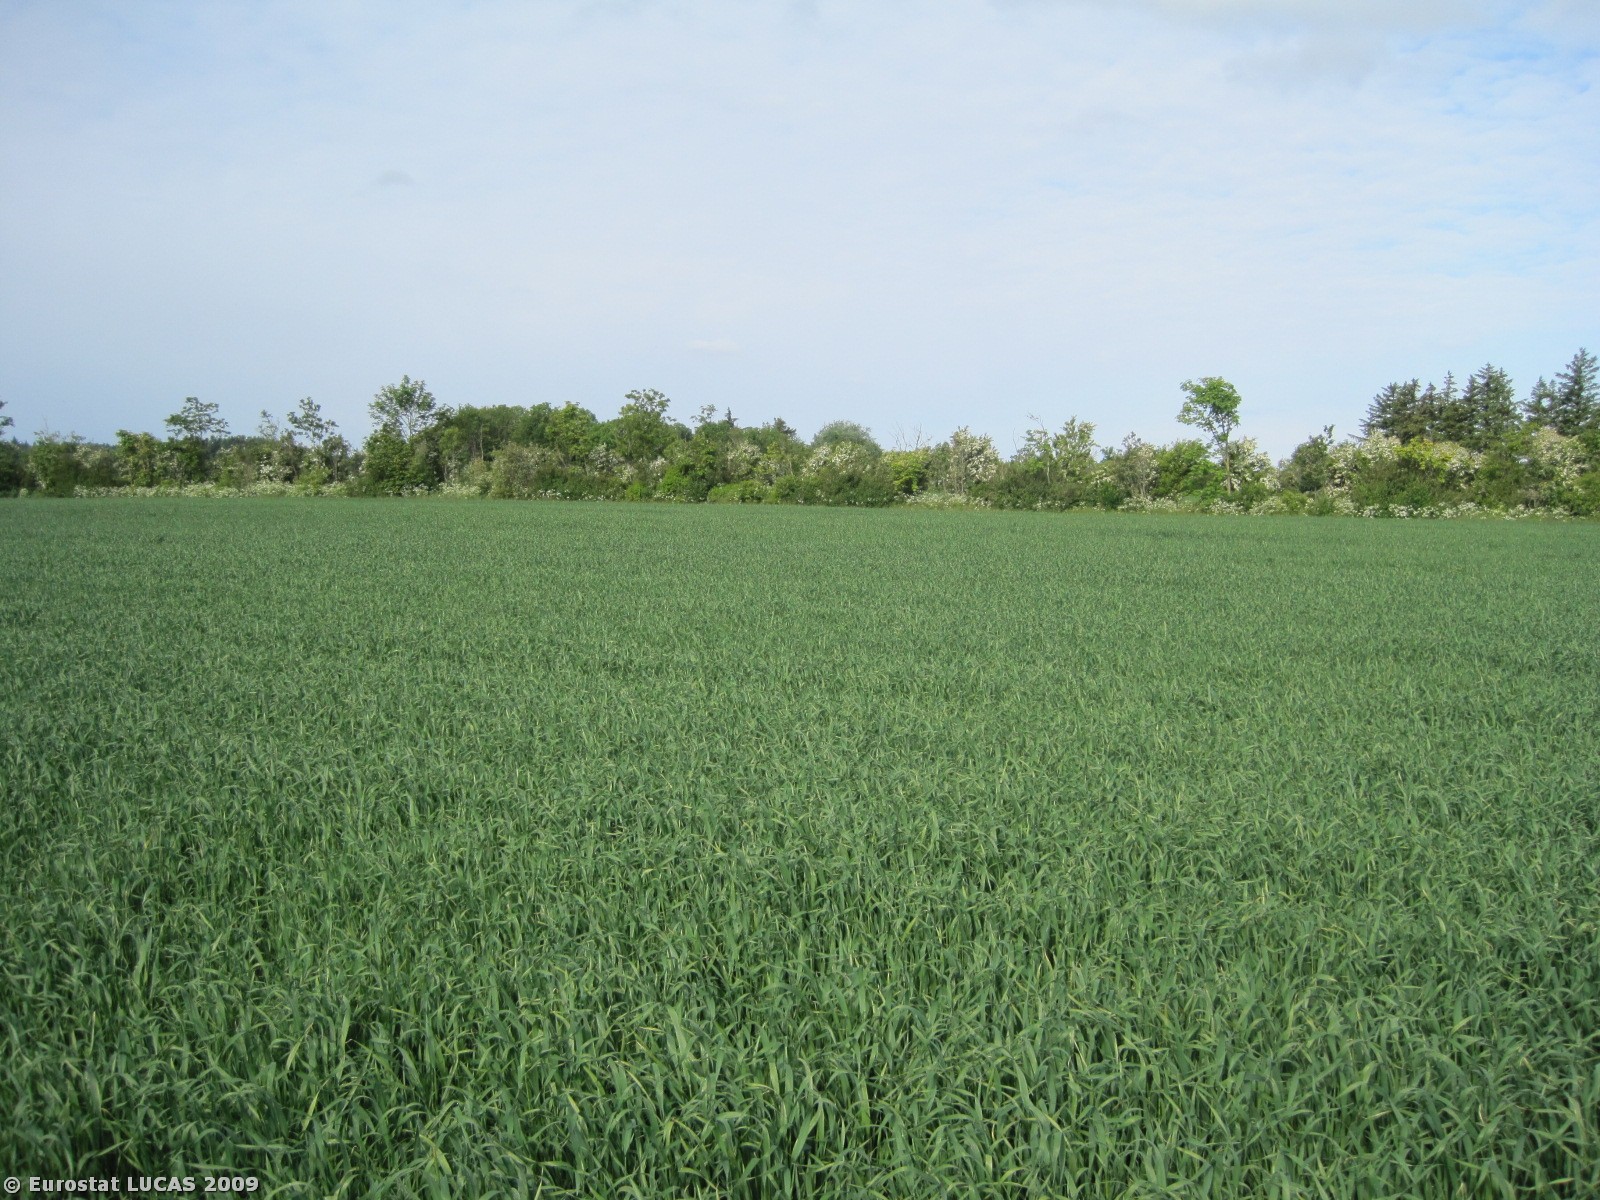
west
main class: Cropland
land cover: Common wheat
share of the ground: > 75 %
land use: Agriculture (excluding fallow land and kitchen gardens)
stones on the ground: < 10 %
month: June
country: DK
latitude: 57.5540
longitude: 10.0834
